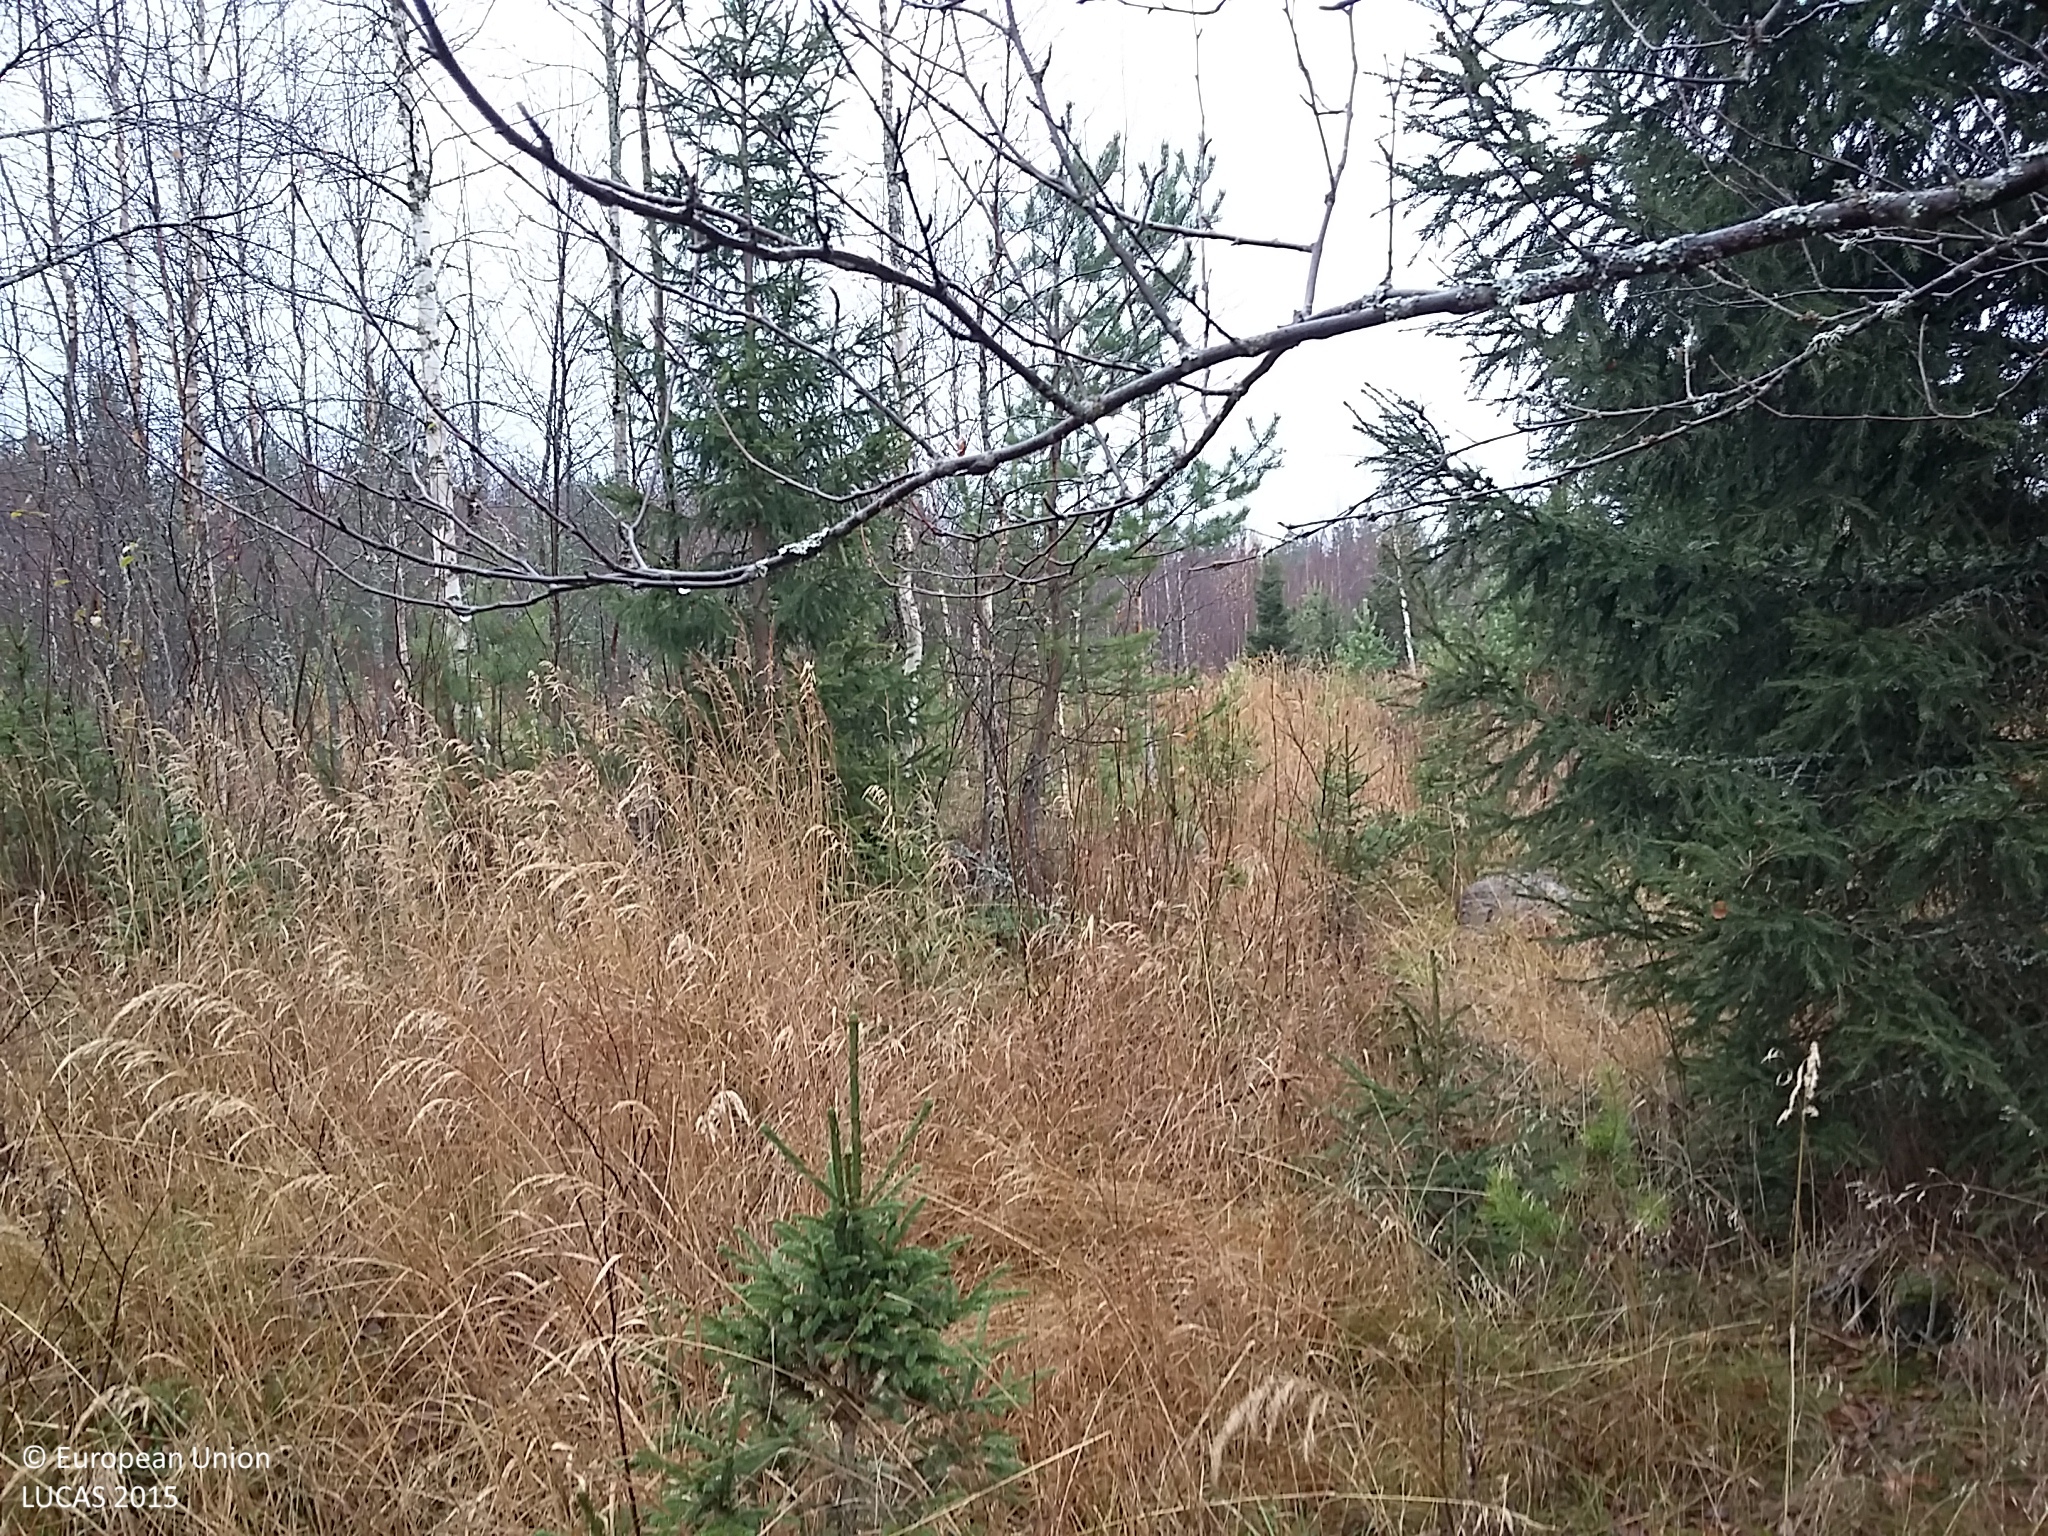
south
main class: Woodland
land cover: Pine dominated mixed woodland
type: boreal forest
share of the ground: 50 - 75 %
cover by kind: coniferous forest trees 40 %, broadleaved forest trees 25 %, herbaceous plants 25 %, lichens and mosses 10 %
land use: Forestry
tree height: < 5 m
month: October
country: FI
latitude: 64.4876
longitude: 25.4247
